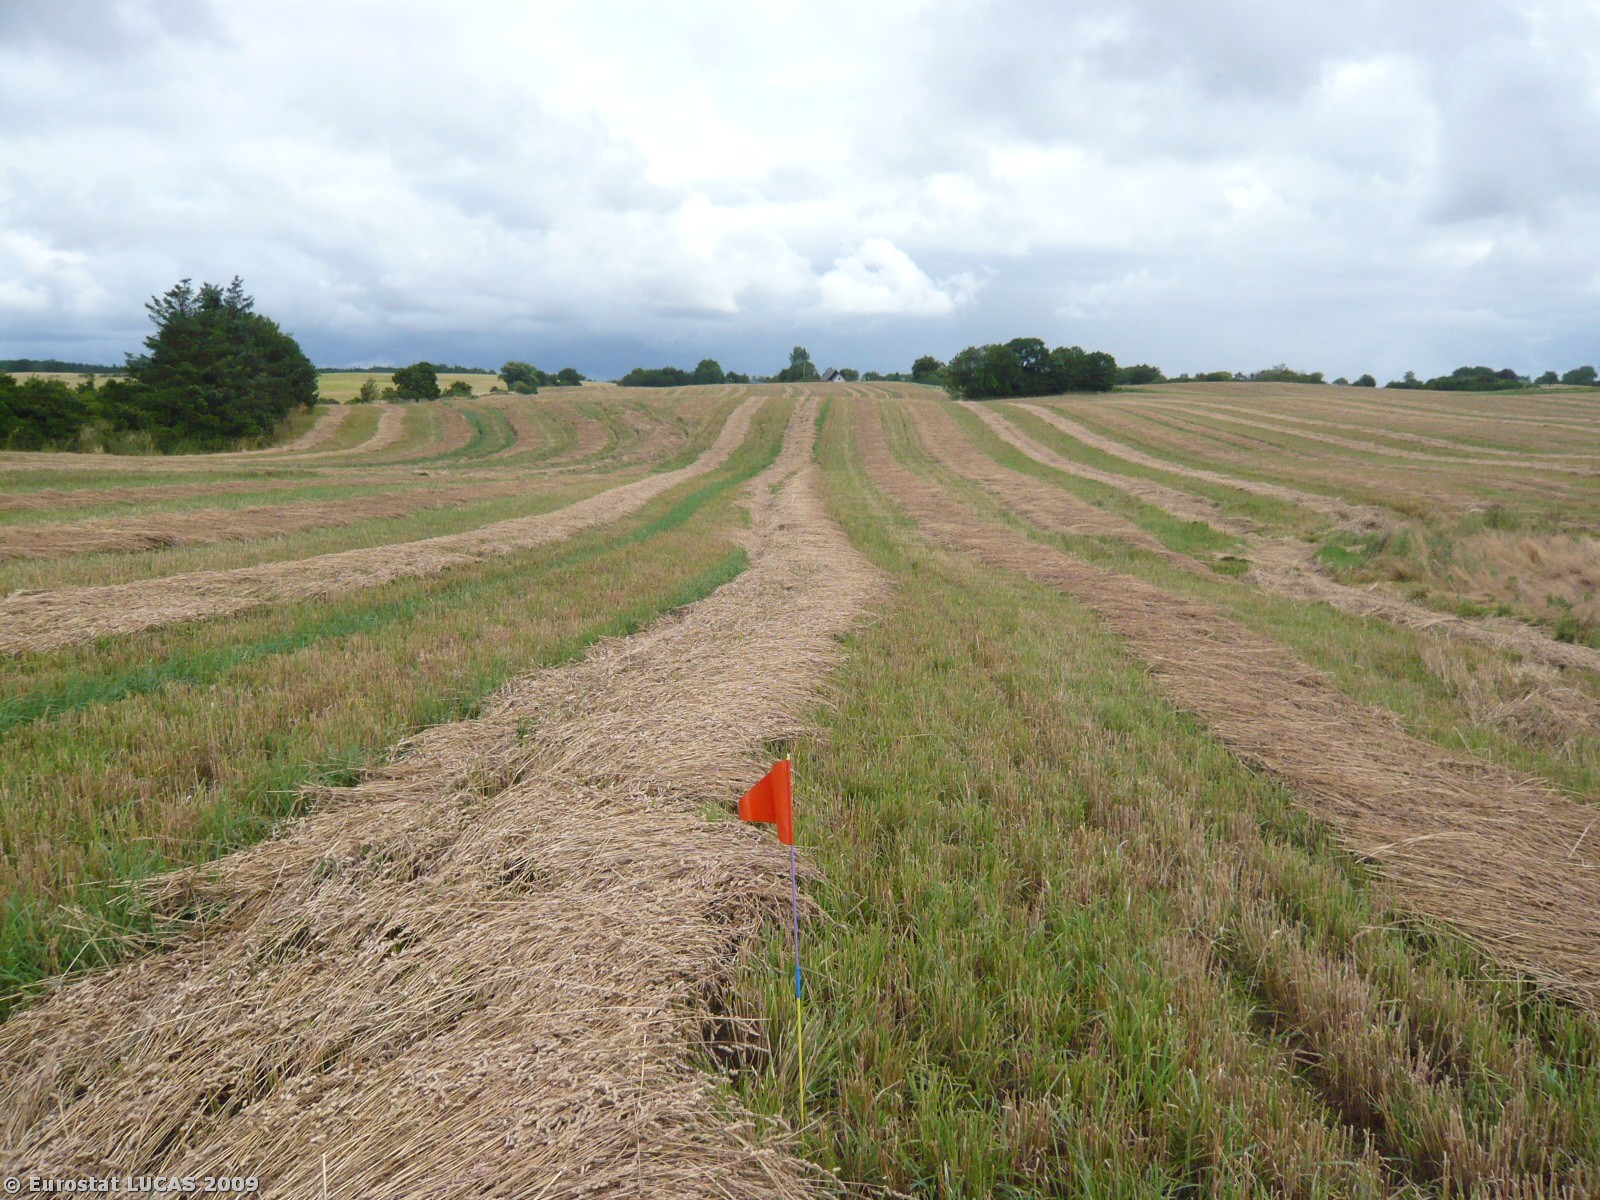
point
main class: Grassland
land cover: Grassland without tree/shrub cover
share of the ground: > 75 %
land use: Agriculture (excluding fallow land and kitchen gardens)
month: July
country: DK
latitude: 55.6240
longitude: 11.2851
